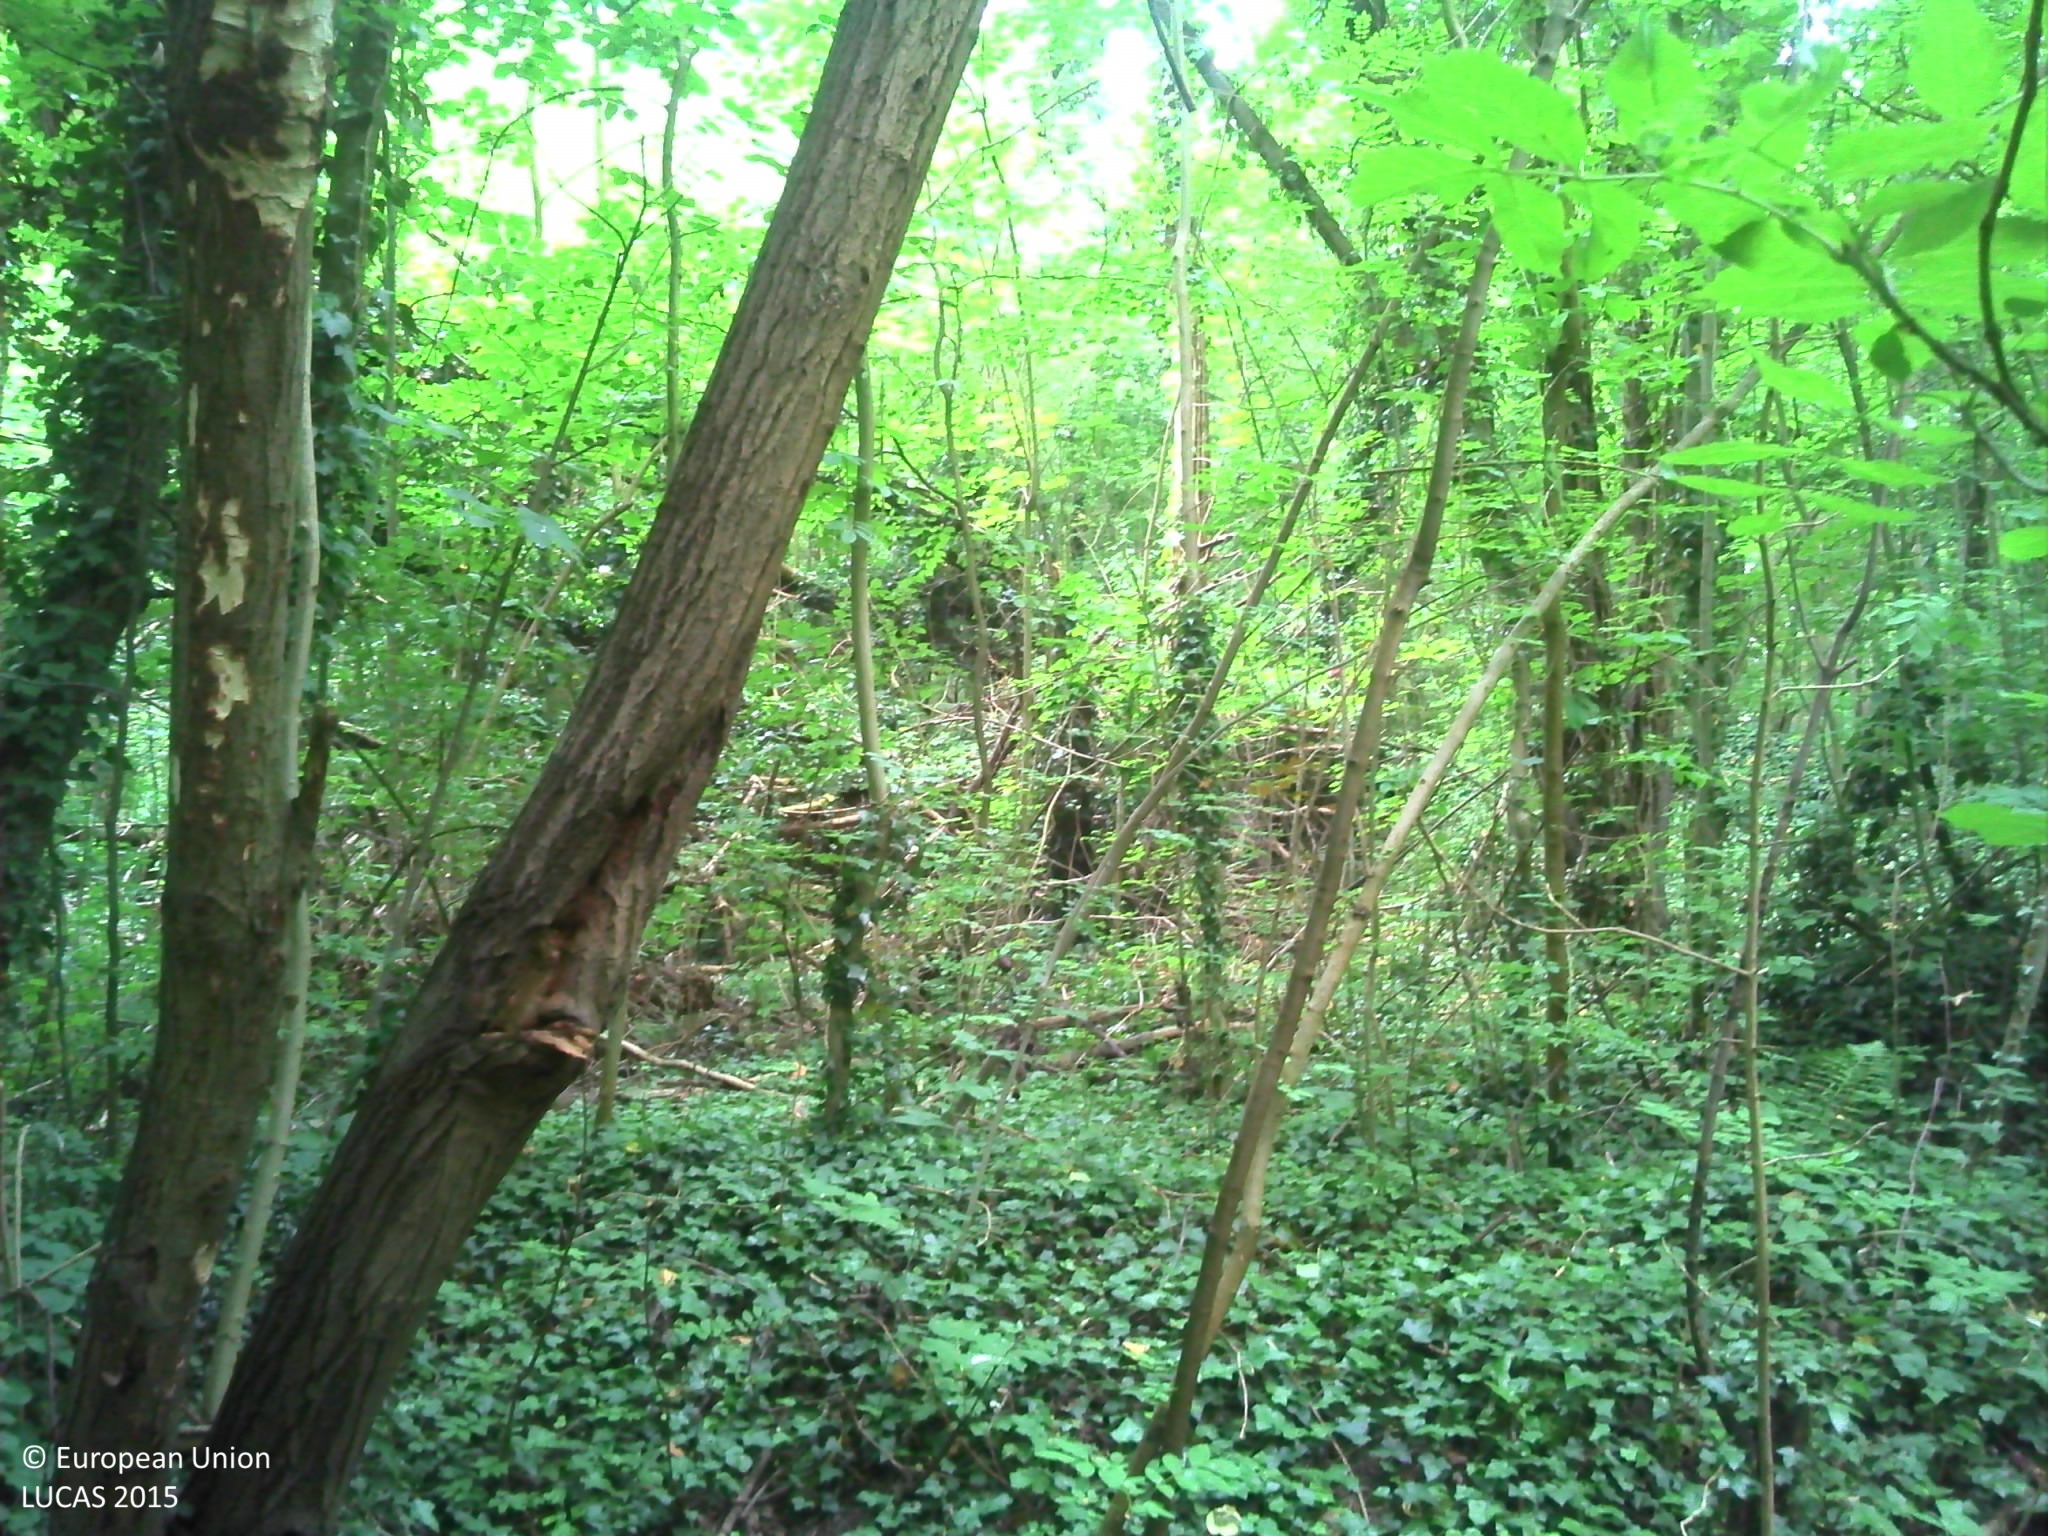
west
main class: Woodland
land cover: Broadleaved woodland
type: acidophilous oak and oak-birch forest
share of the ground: > 75 %
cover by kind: broadleaved forest trees 75 %, herbaceous plants 15 %, coniferous forest trees 10 %
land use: Forestry
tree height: > 5 m
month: June
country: BE
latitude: 50.8624
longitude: 4.4974
